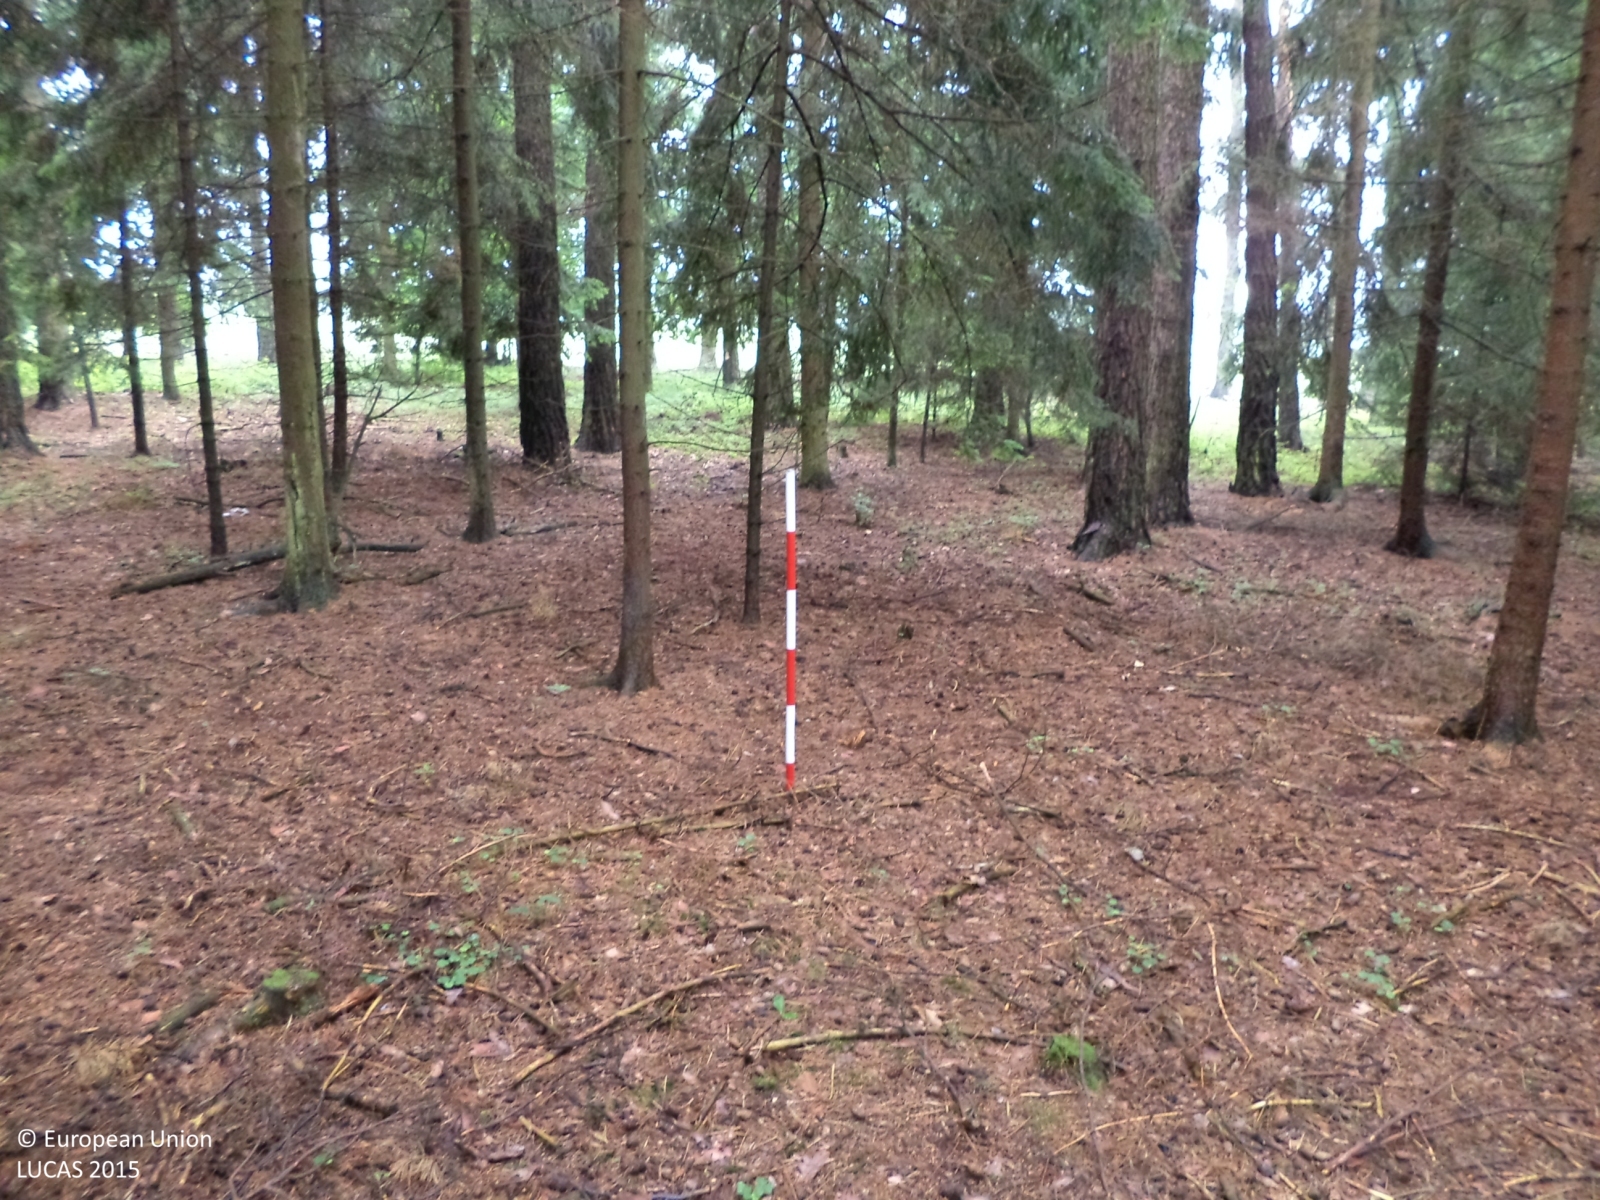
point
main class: Woodland
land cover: Spruce dominated coniferous woodland
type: hemiboreal forest and nemoral coniferous forest and mixed broadleaved-coniferous forest
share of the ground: > 75 %
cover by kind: coniferous forest trees 95 %, herbaceous plants 5 %
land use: Forestry
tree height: > 5 m
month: June
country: CZ
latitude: 49.2007
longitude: 14.3516
